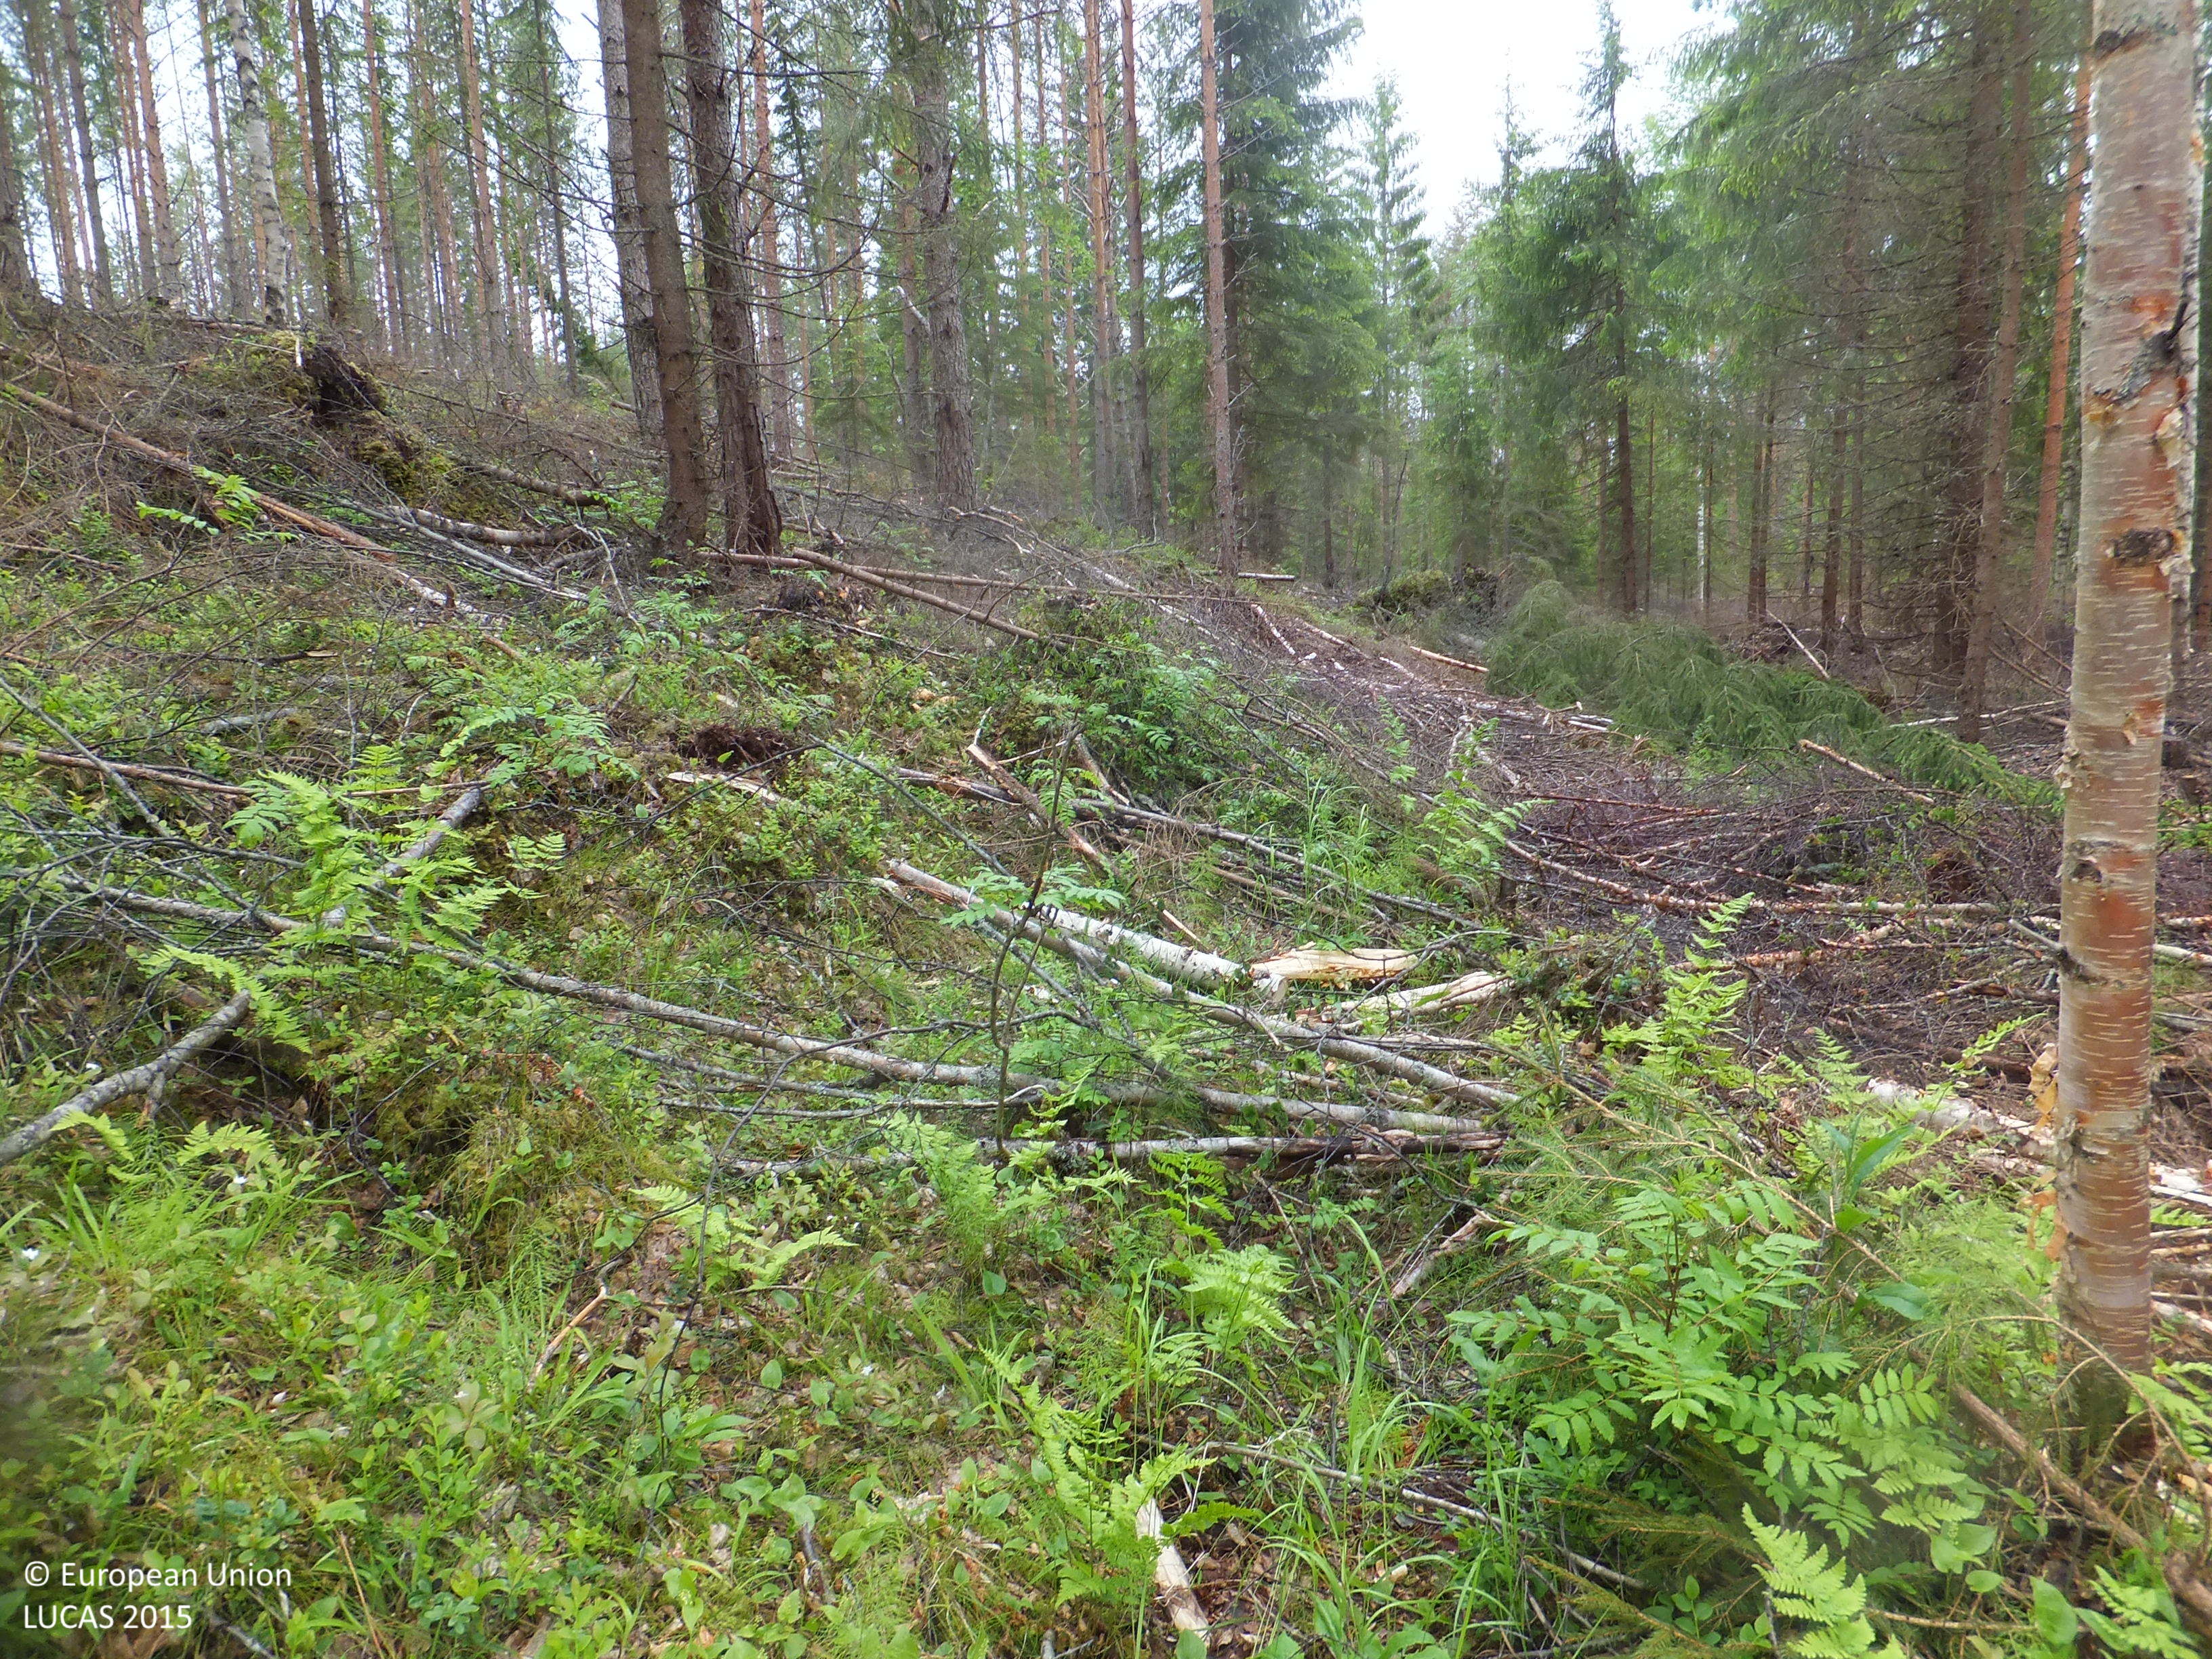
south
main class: Woodland
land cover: Pine dominated coniferous woodland
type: boreal forest
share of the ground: > 75 %
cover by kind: coniferous forest trees 75 %, broadleaved forest trees 10 %, shrubs 10 %, lichens and mosses 5 %
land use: Forestry
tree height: > 5 m
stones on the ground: < 10 %
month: June
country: FI
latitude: 63.6456
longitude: 24.9685
